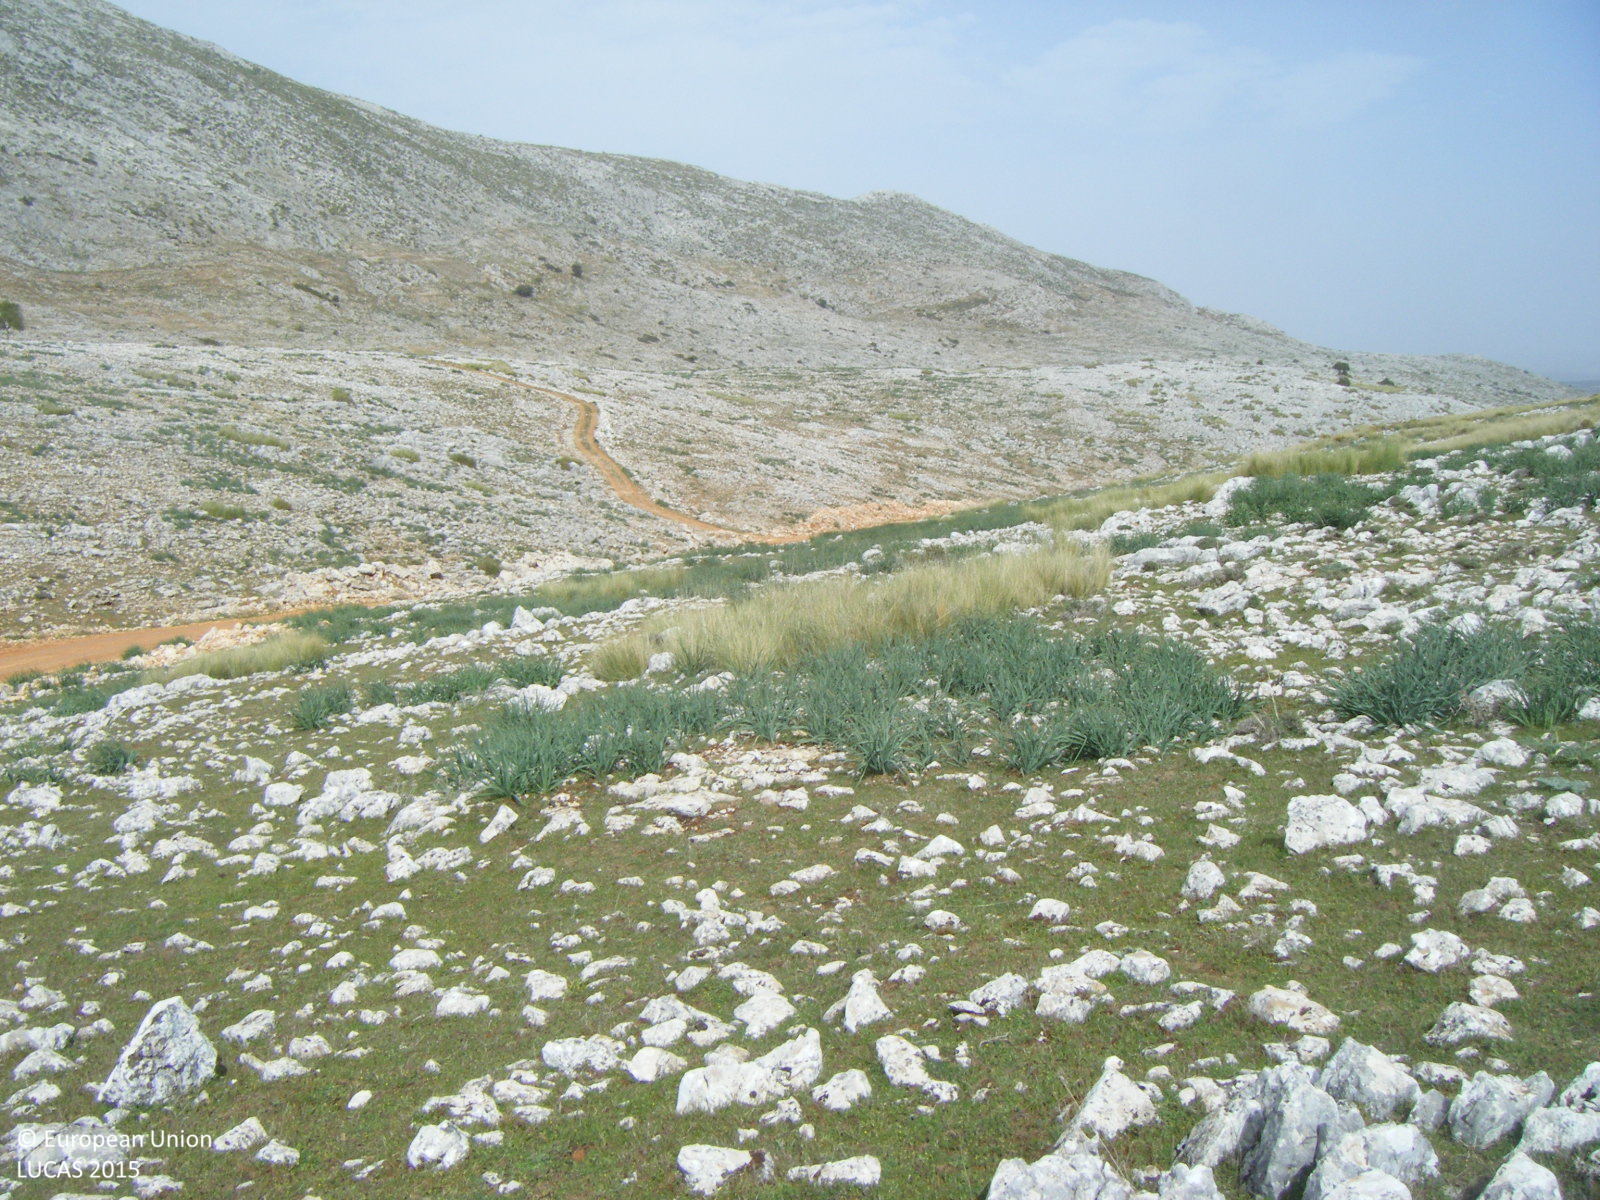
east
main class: Grassland
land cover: Grassland without tree/shrub cover
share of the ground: > 75 %
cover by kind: herbaceous plants 75 %, consolidated bare surface 25 %
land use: Agriculture (excluding fallow land and kitchen gardens)
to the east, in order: Grassland without tree/shrub cover
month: April
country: ES
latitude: 37.0580
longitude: -4.1055
